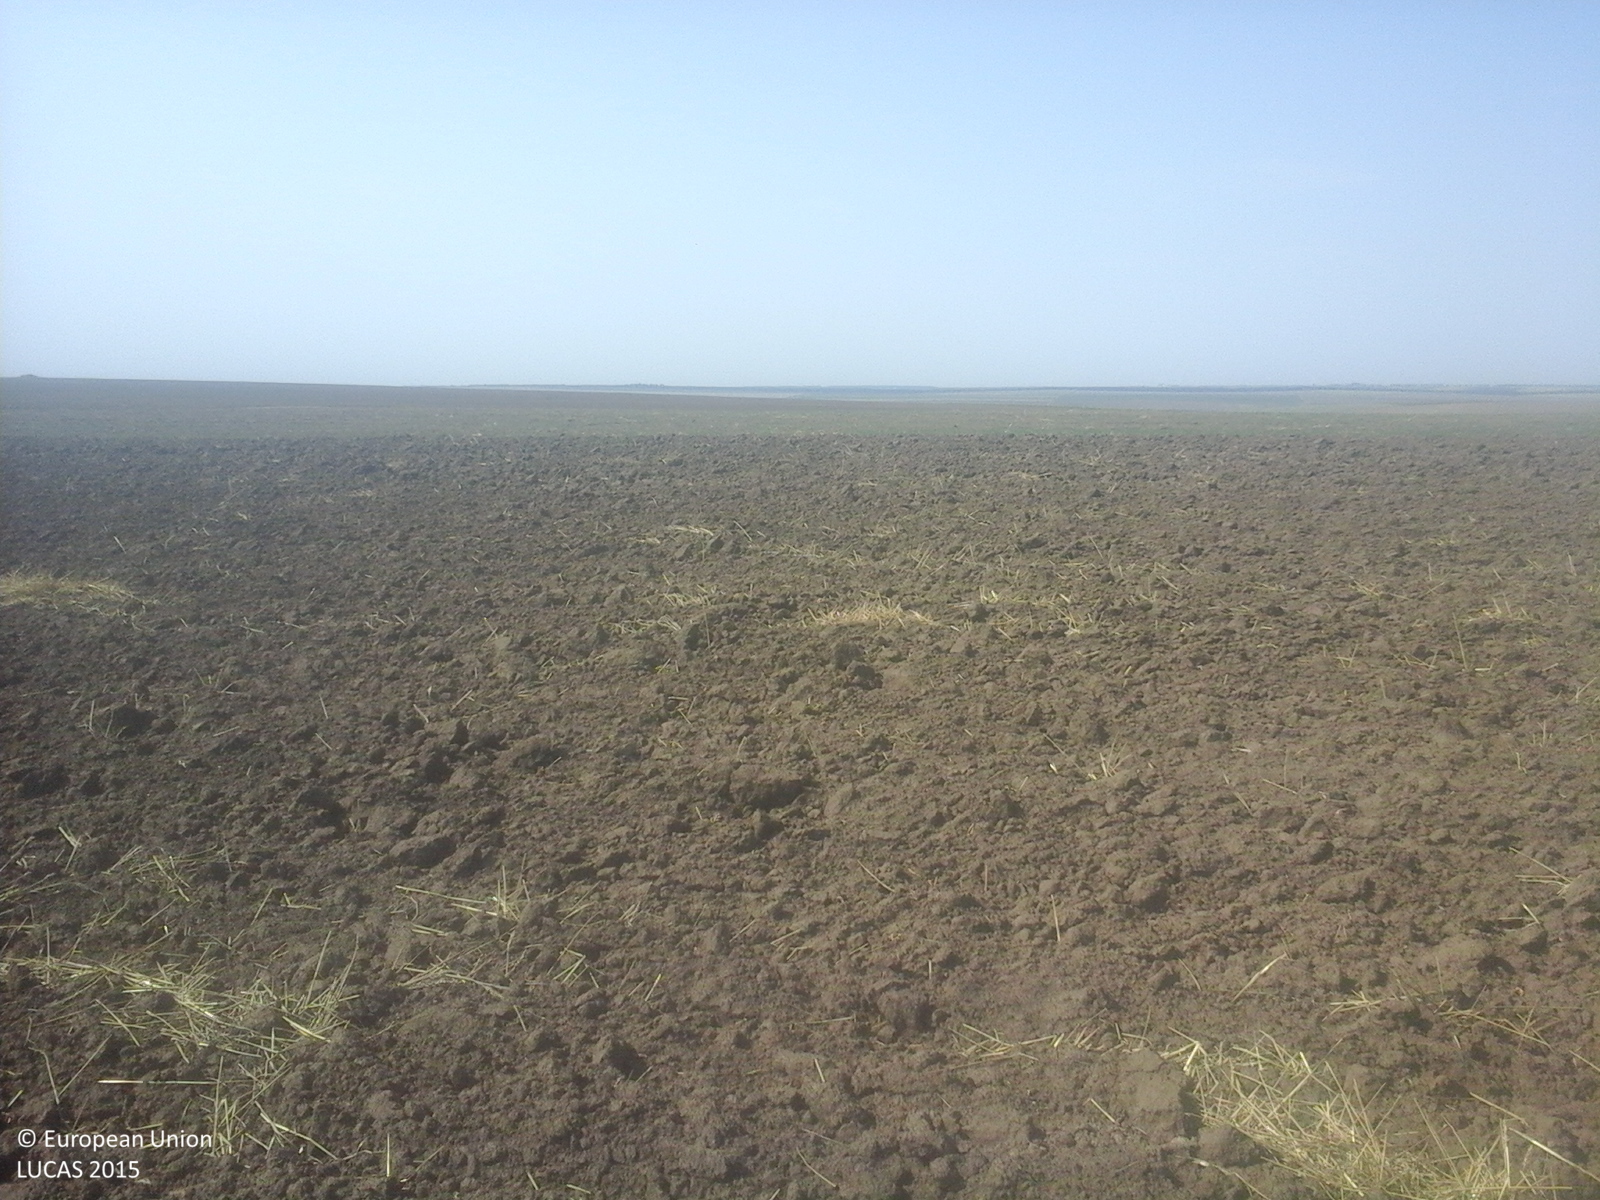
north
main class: Cropland
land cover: Common wheat
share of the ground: < 10 %
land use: Agriculture (excluding fallow land and kitchen gardens)
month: August
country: RO
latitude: 43.9536
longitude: 28.2398
